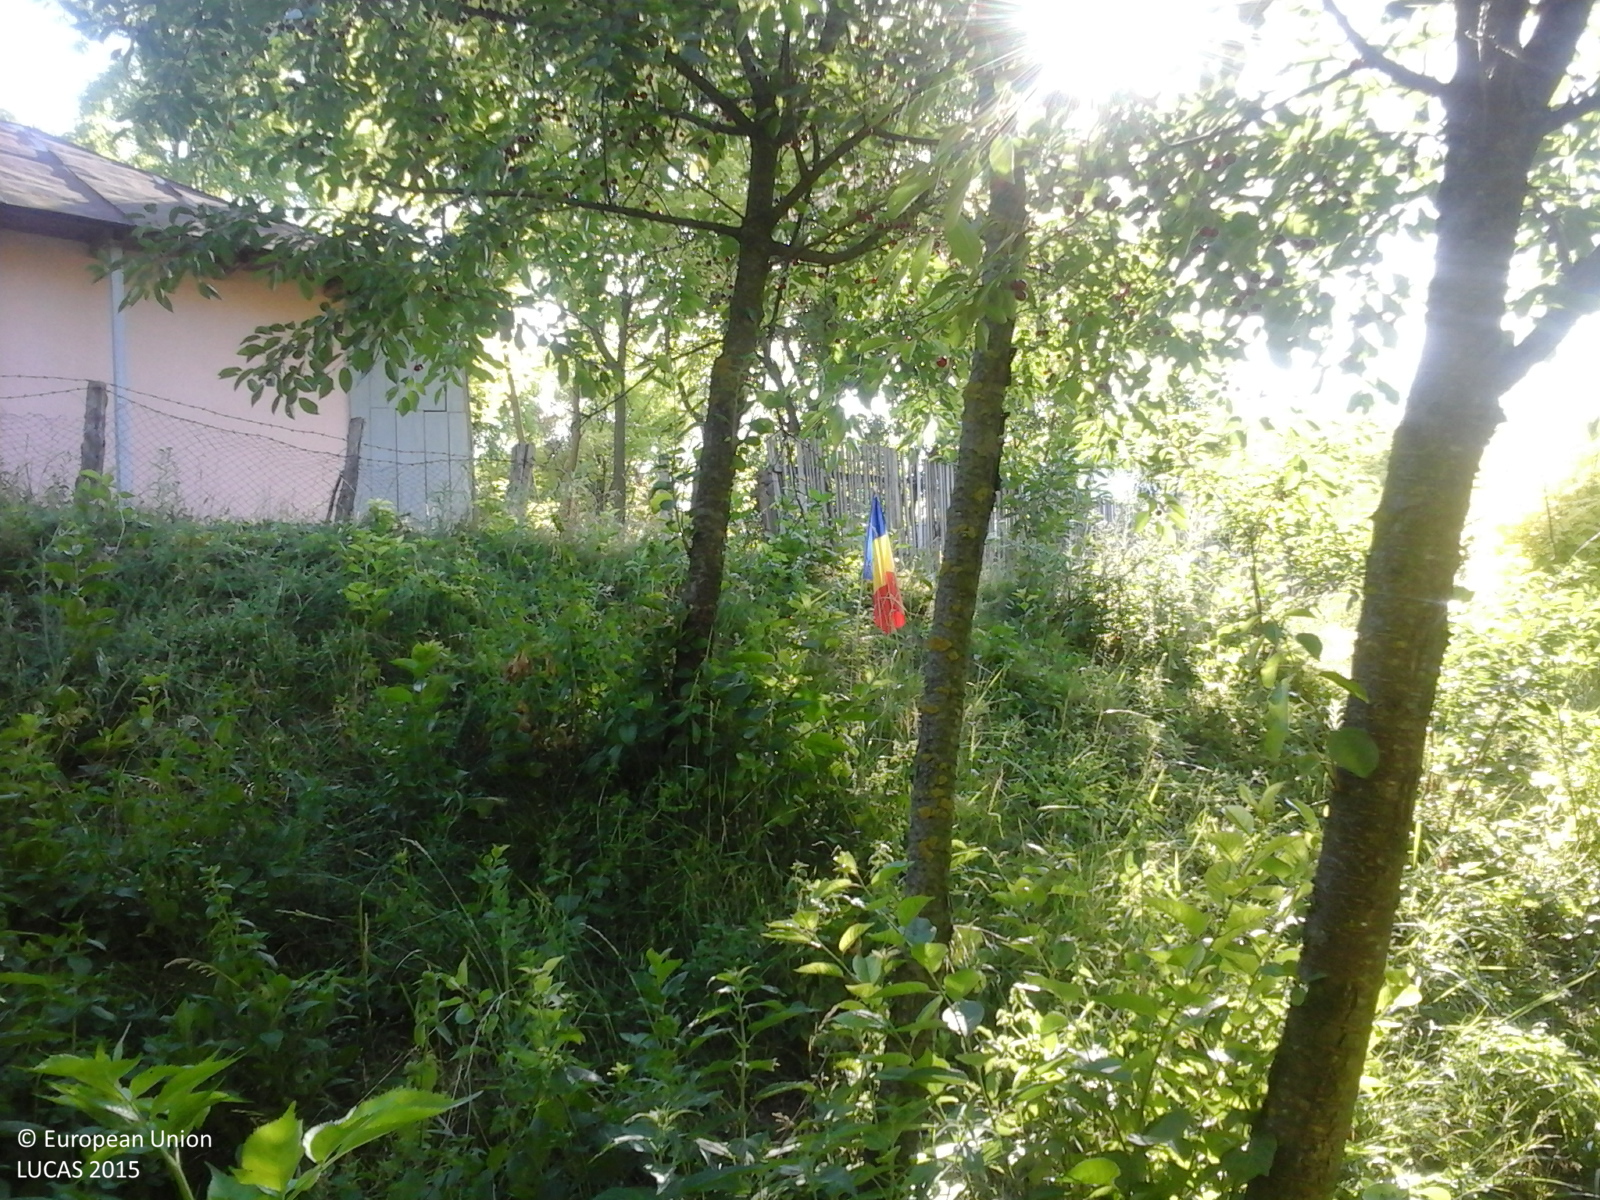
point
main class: Woodland
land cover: Broadleaved woodland
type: broadleaved evergreen forest
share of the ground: > 75 %
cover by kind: broadleaved forest trees 100 %
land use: Forestry
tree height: > 5 m
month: June
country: RO
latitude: 47.7551
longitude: 27.2266
